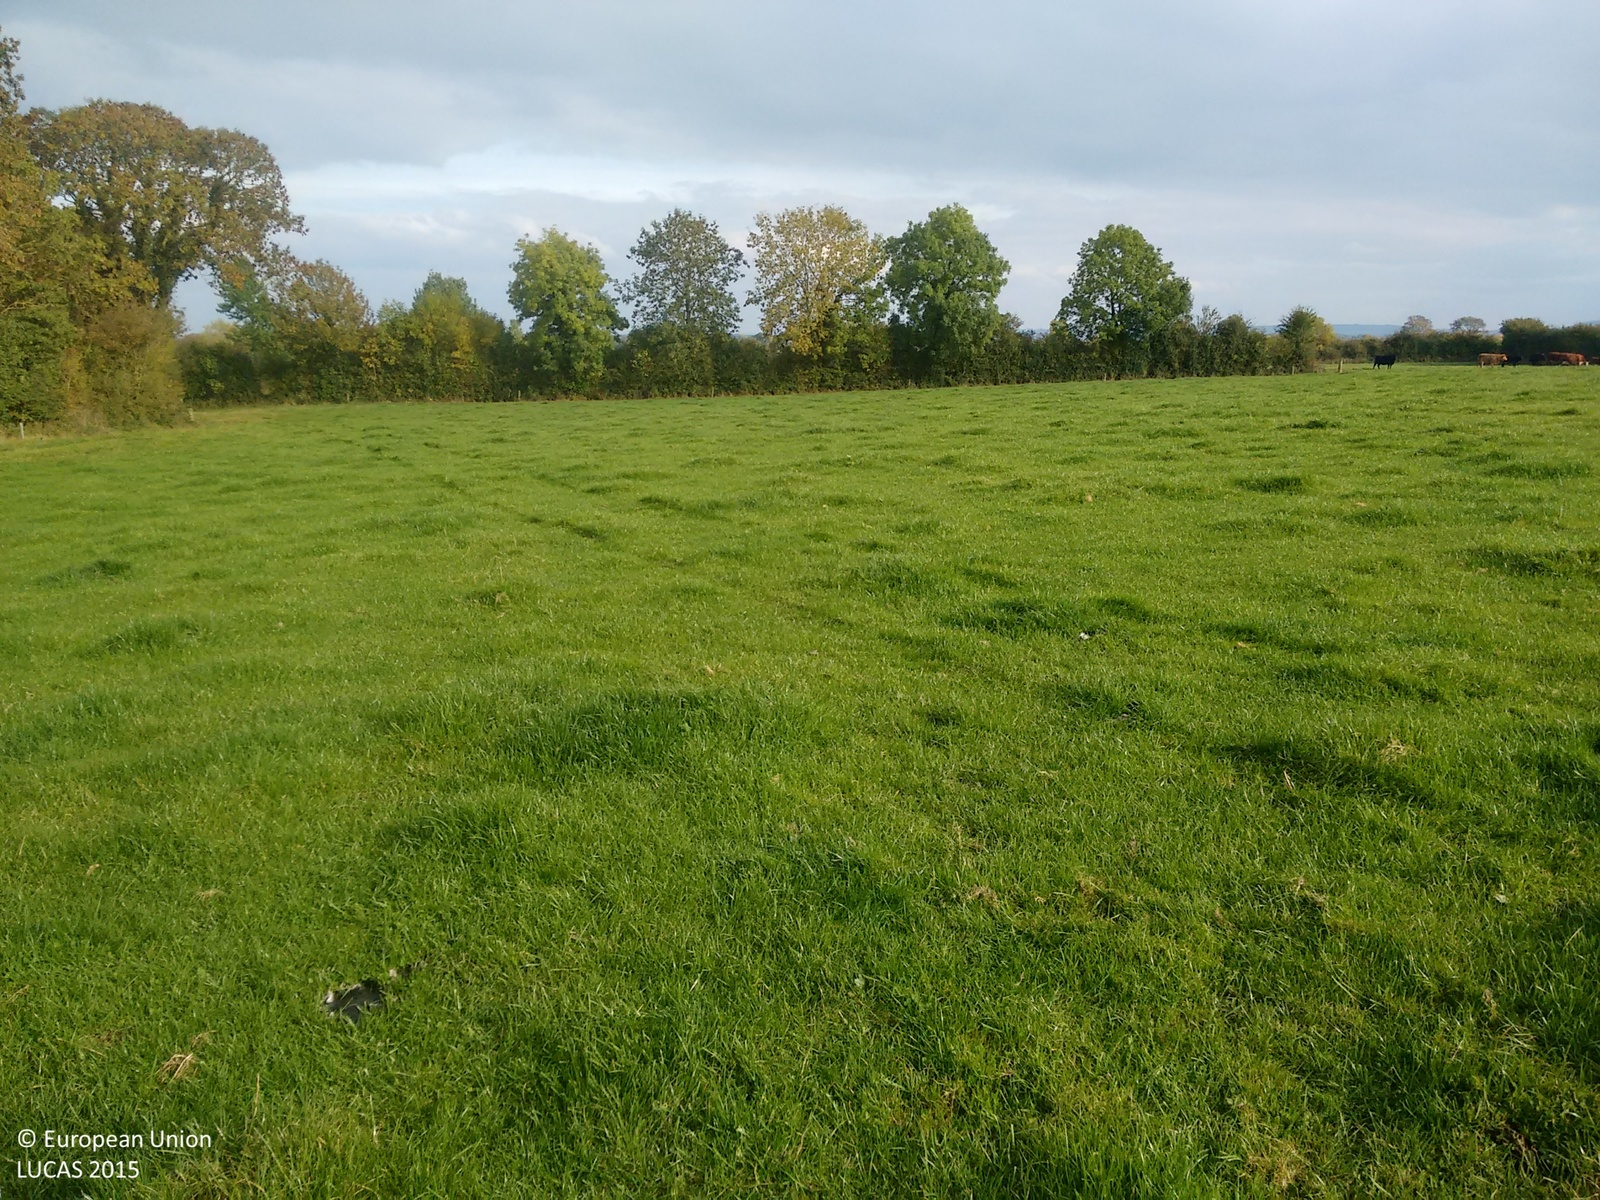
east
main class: Grassland
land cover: Grassland without tree/shrub cover
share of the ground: > 75 %
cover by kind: herbaceous plants 100 %
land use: Agriculture (excluding fallow land and kitchen gardens)
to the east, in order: Grassland without tree/shrub cover; Fences; Managed hedges; Grassland without tree/shrub cover; Fences; Broadleaved woodland; Fences; Grassland without tree/shrub cover
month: October
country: IE
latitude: 52.8690
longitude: -7.6180
